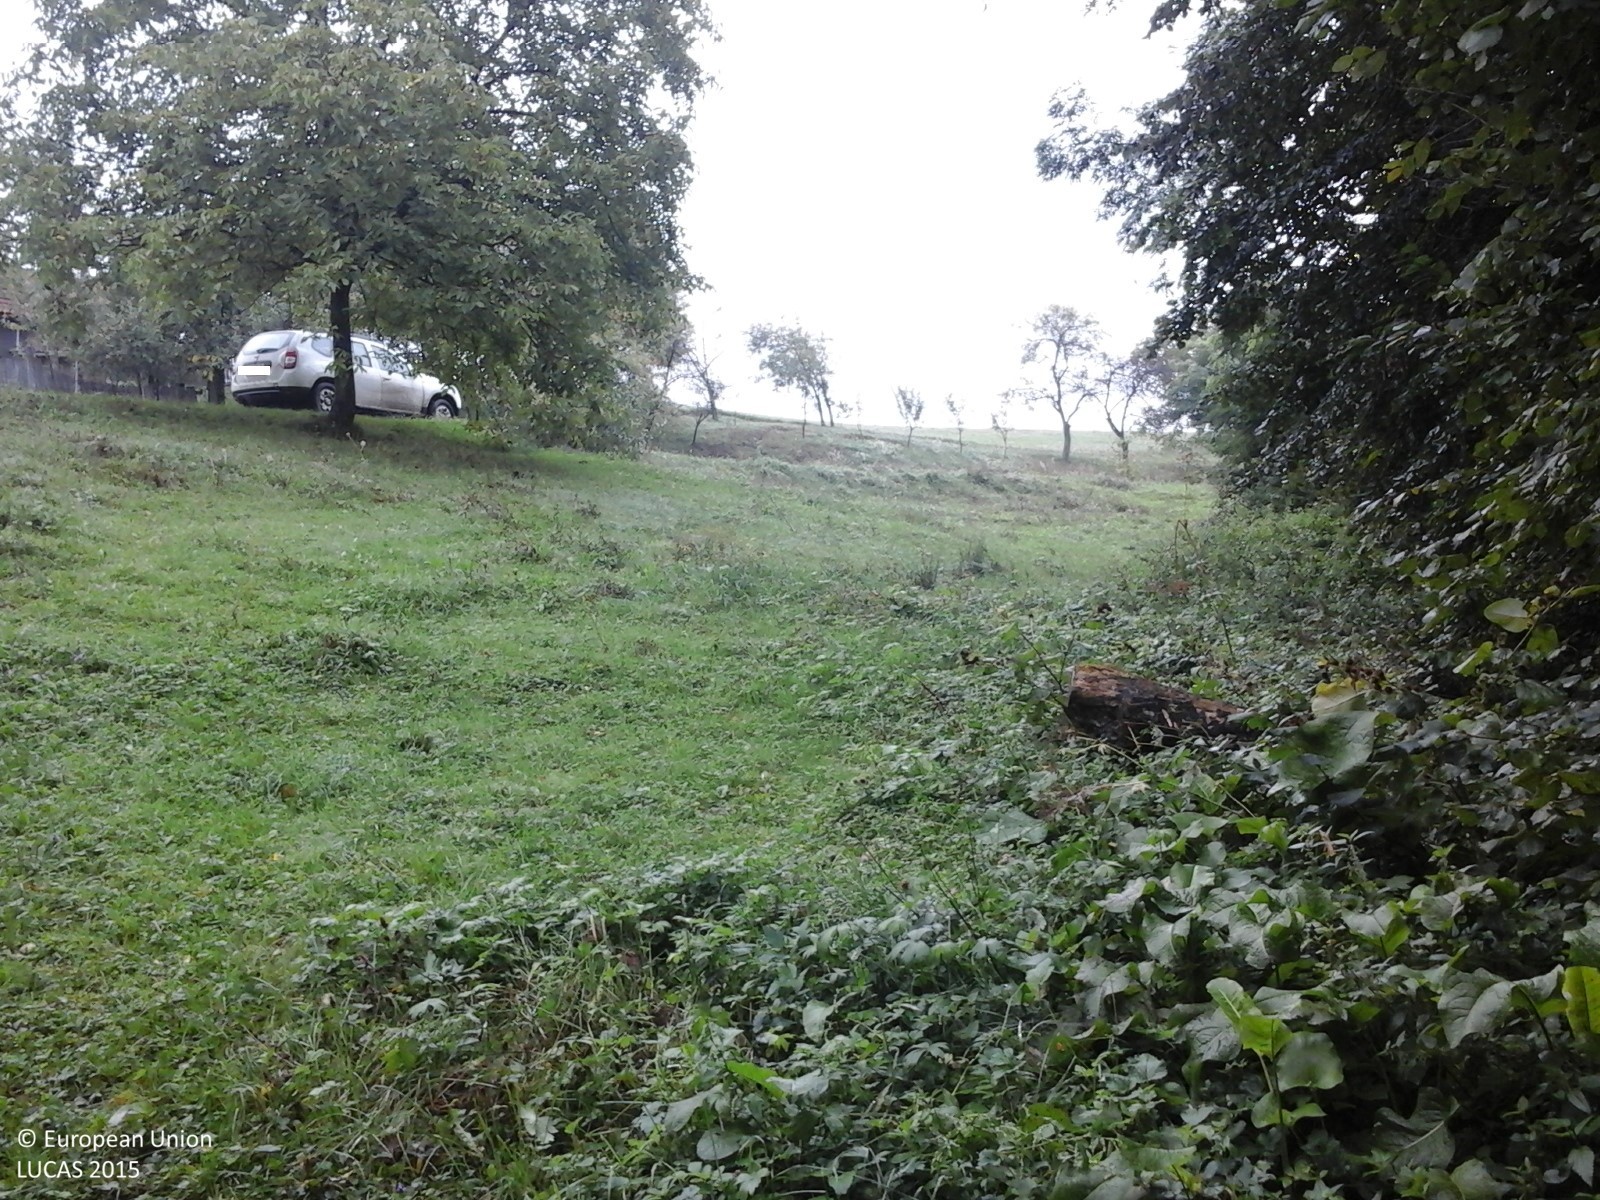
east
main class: Woodland
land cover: Broadleaved woodland
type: exotic forest
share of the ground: > 75 %
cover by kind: broadleaved forest trees 100 %
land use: Forestry
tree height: > 5 m
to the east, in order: Broadleaved woodland; Grassland with sparse tree/shrub cover; Tracks; Grassland with sparse tree/shrub cover; Grassland without tree/shrub cover; Spontaneously vegetated surfaces; Grassland without tree/shrub cover
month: September
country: RO
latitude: 47.0304
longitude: 22.5426
